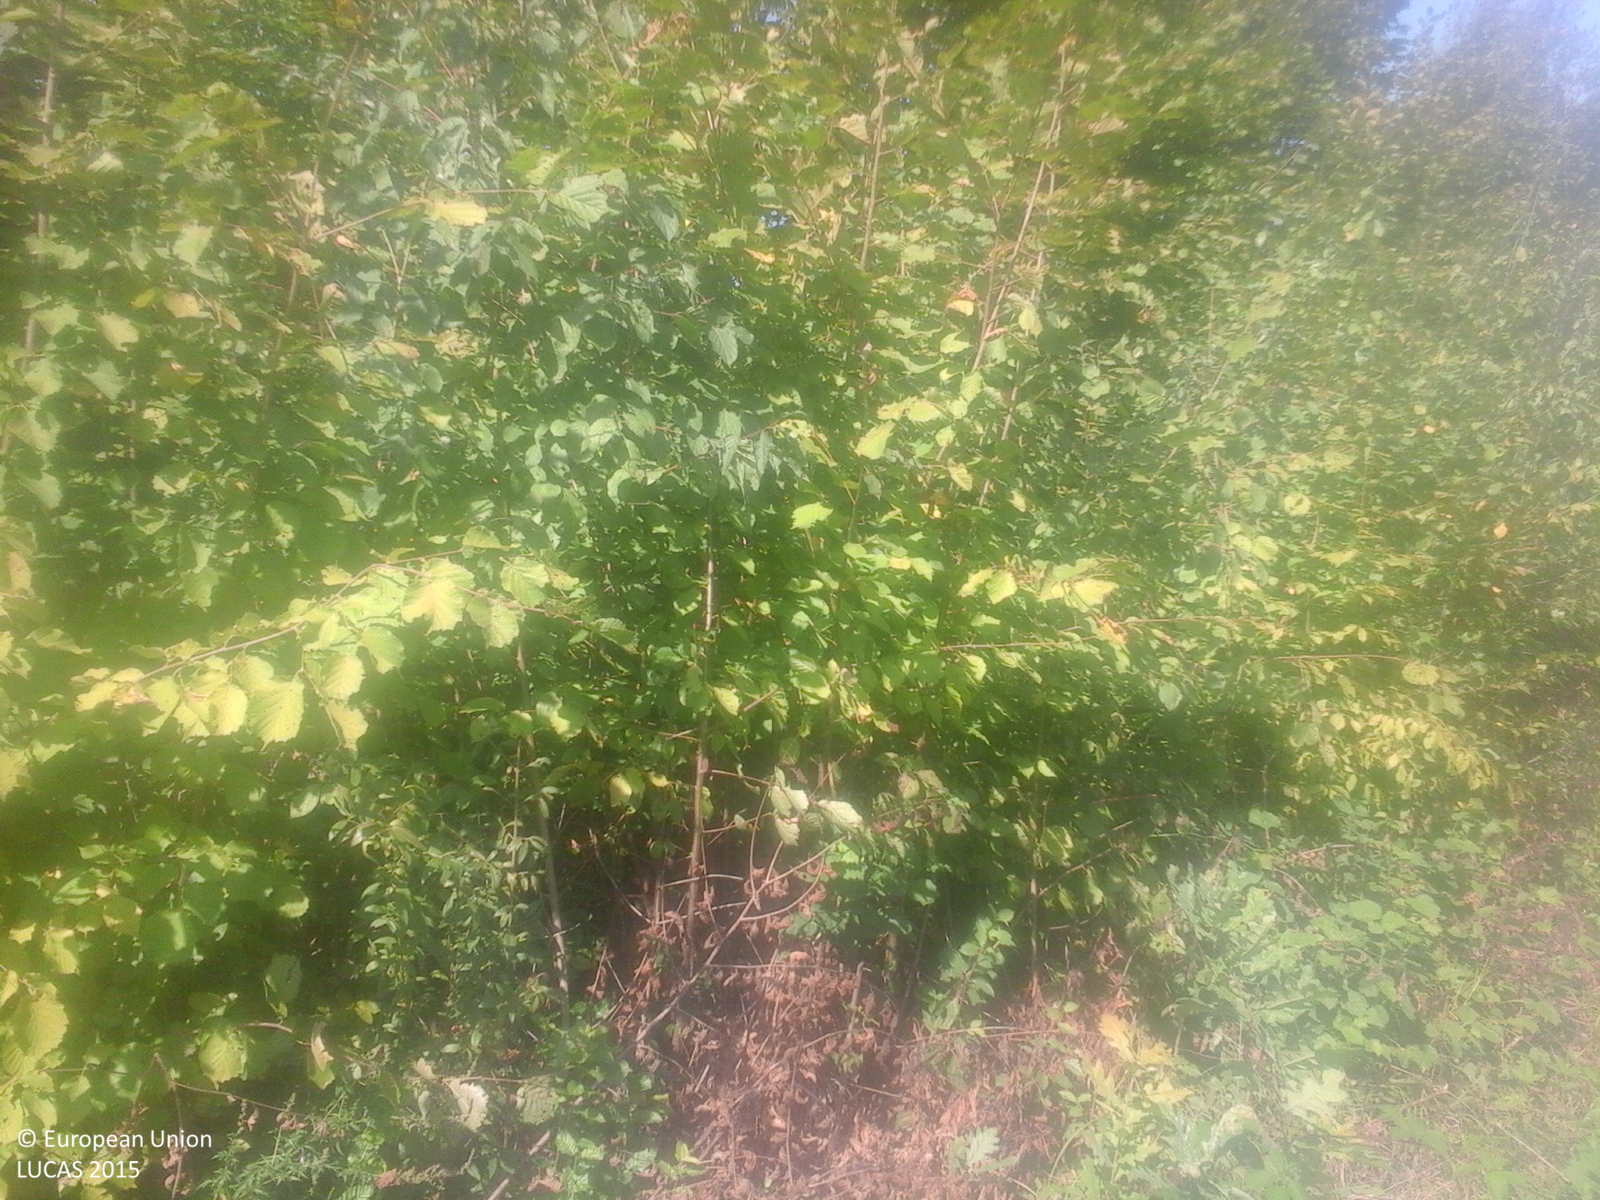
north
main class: Woodland
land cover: Broadleaved woodland
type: acidophilous oak and oak-birch forest
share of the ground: > 75 %
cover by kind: broadleaved forest trees 100 %
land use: Forestry
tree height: > 5 m
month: September
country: RO
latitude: 46.6586
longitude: 22.2943
